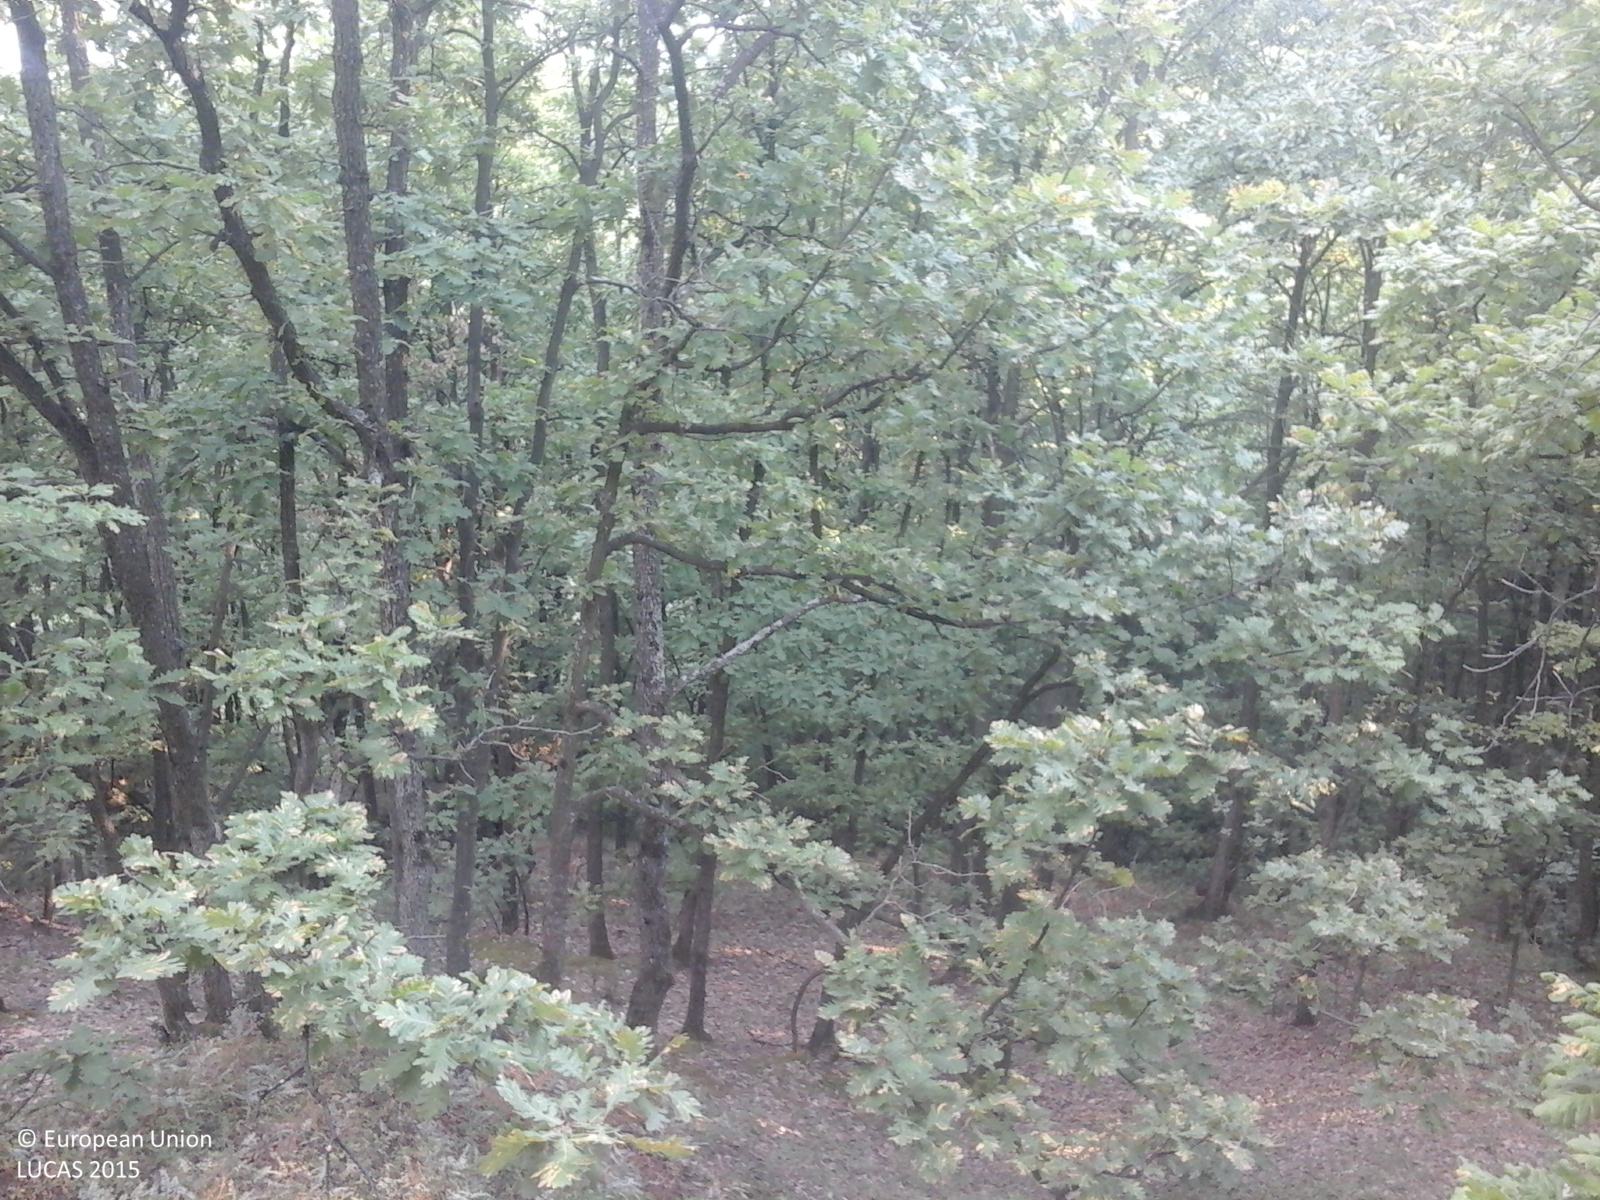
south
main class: Woodland
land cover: Broadleaved woodland
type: acidophilous oak and oak-birch forest
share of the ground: > 75 %
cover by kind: broadleaved forest trees 100 %
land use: Forestry
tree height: > 5 m
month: August
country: RO
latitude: 44.6511
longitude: 23.6374
